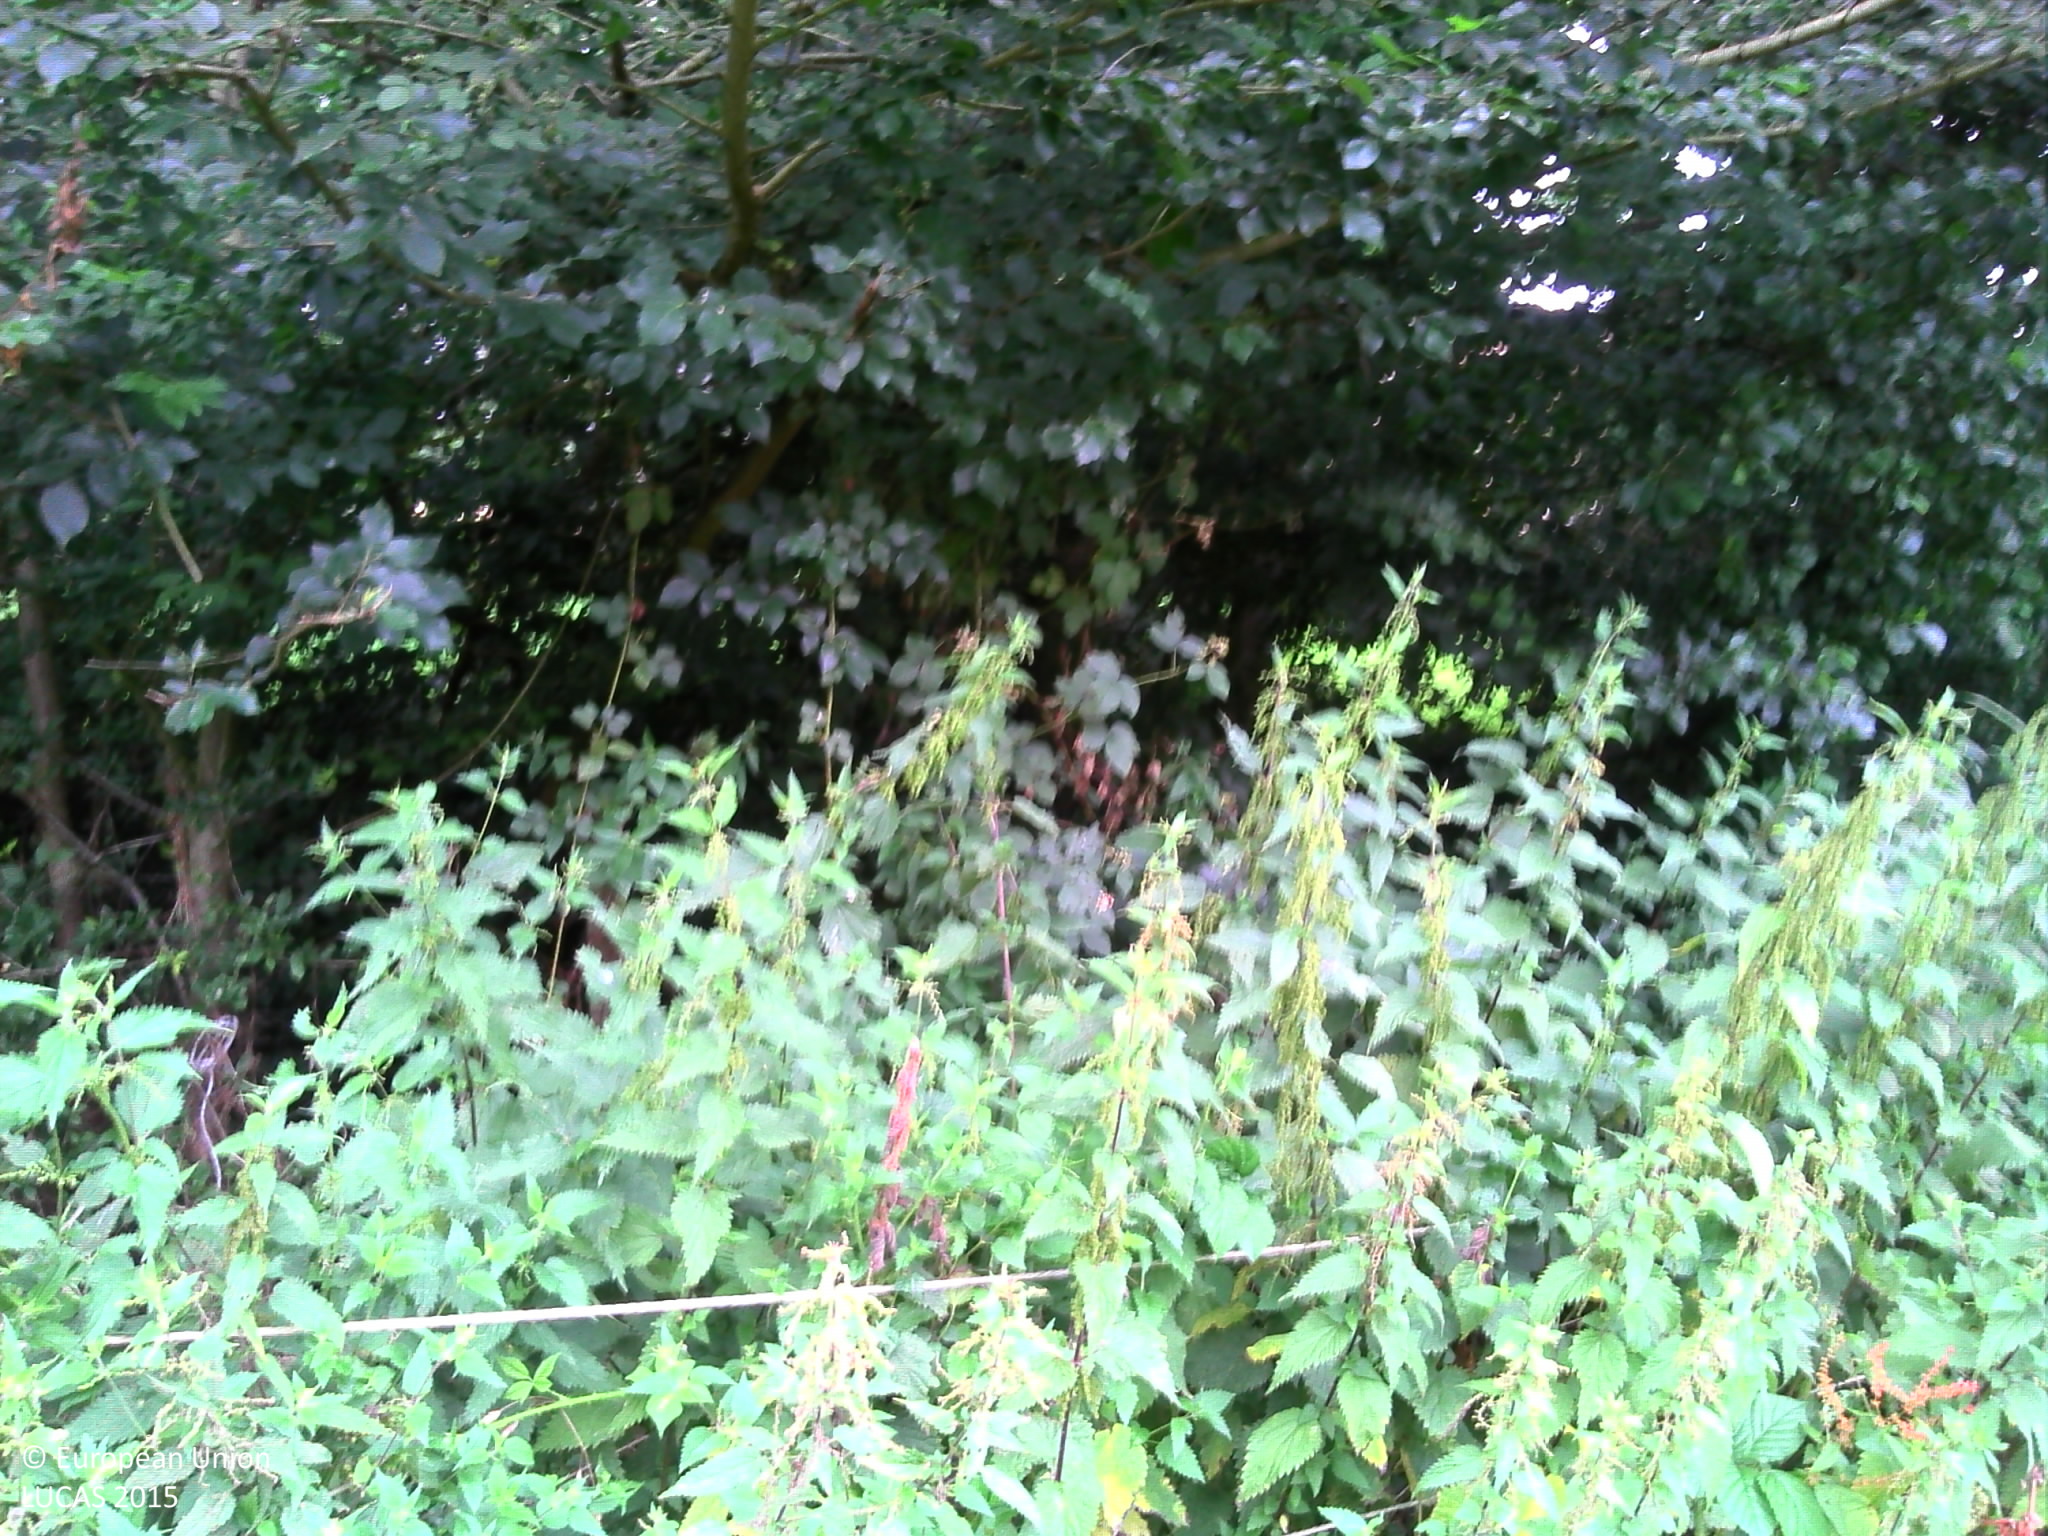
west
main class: Grassland
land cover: Grassland without tree/shrub cover
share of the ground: > 75 %
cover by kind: herbaceous plants 100 %
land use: Residential
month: July
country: FR
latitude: 49.0270
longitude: -0.3048
